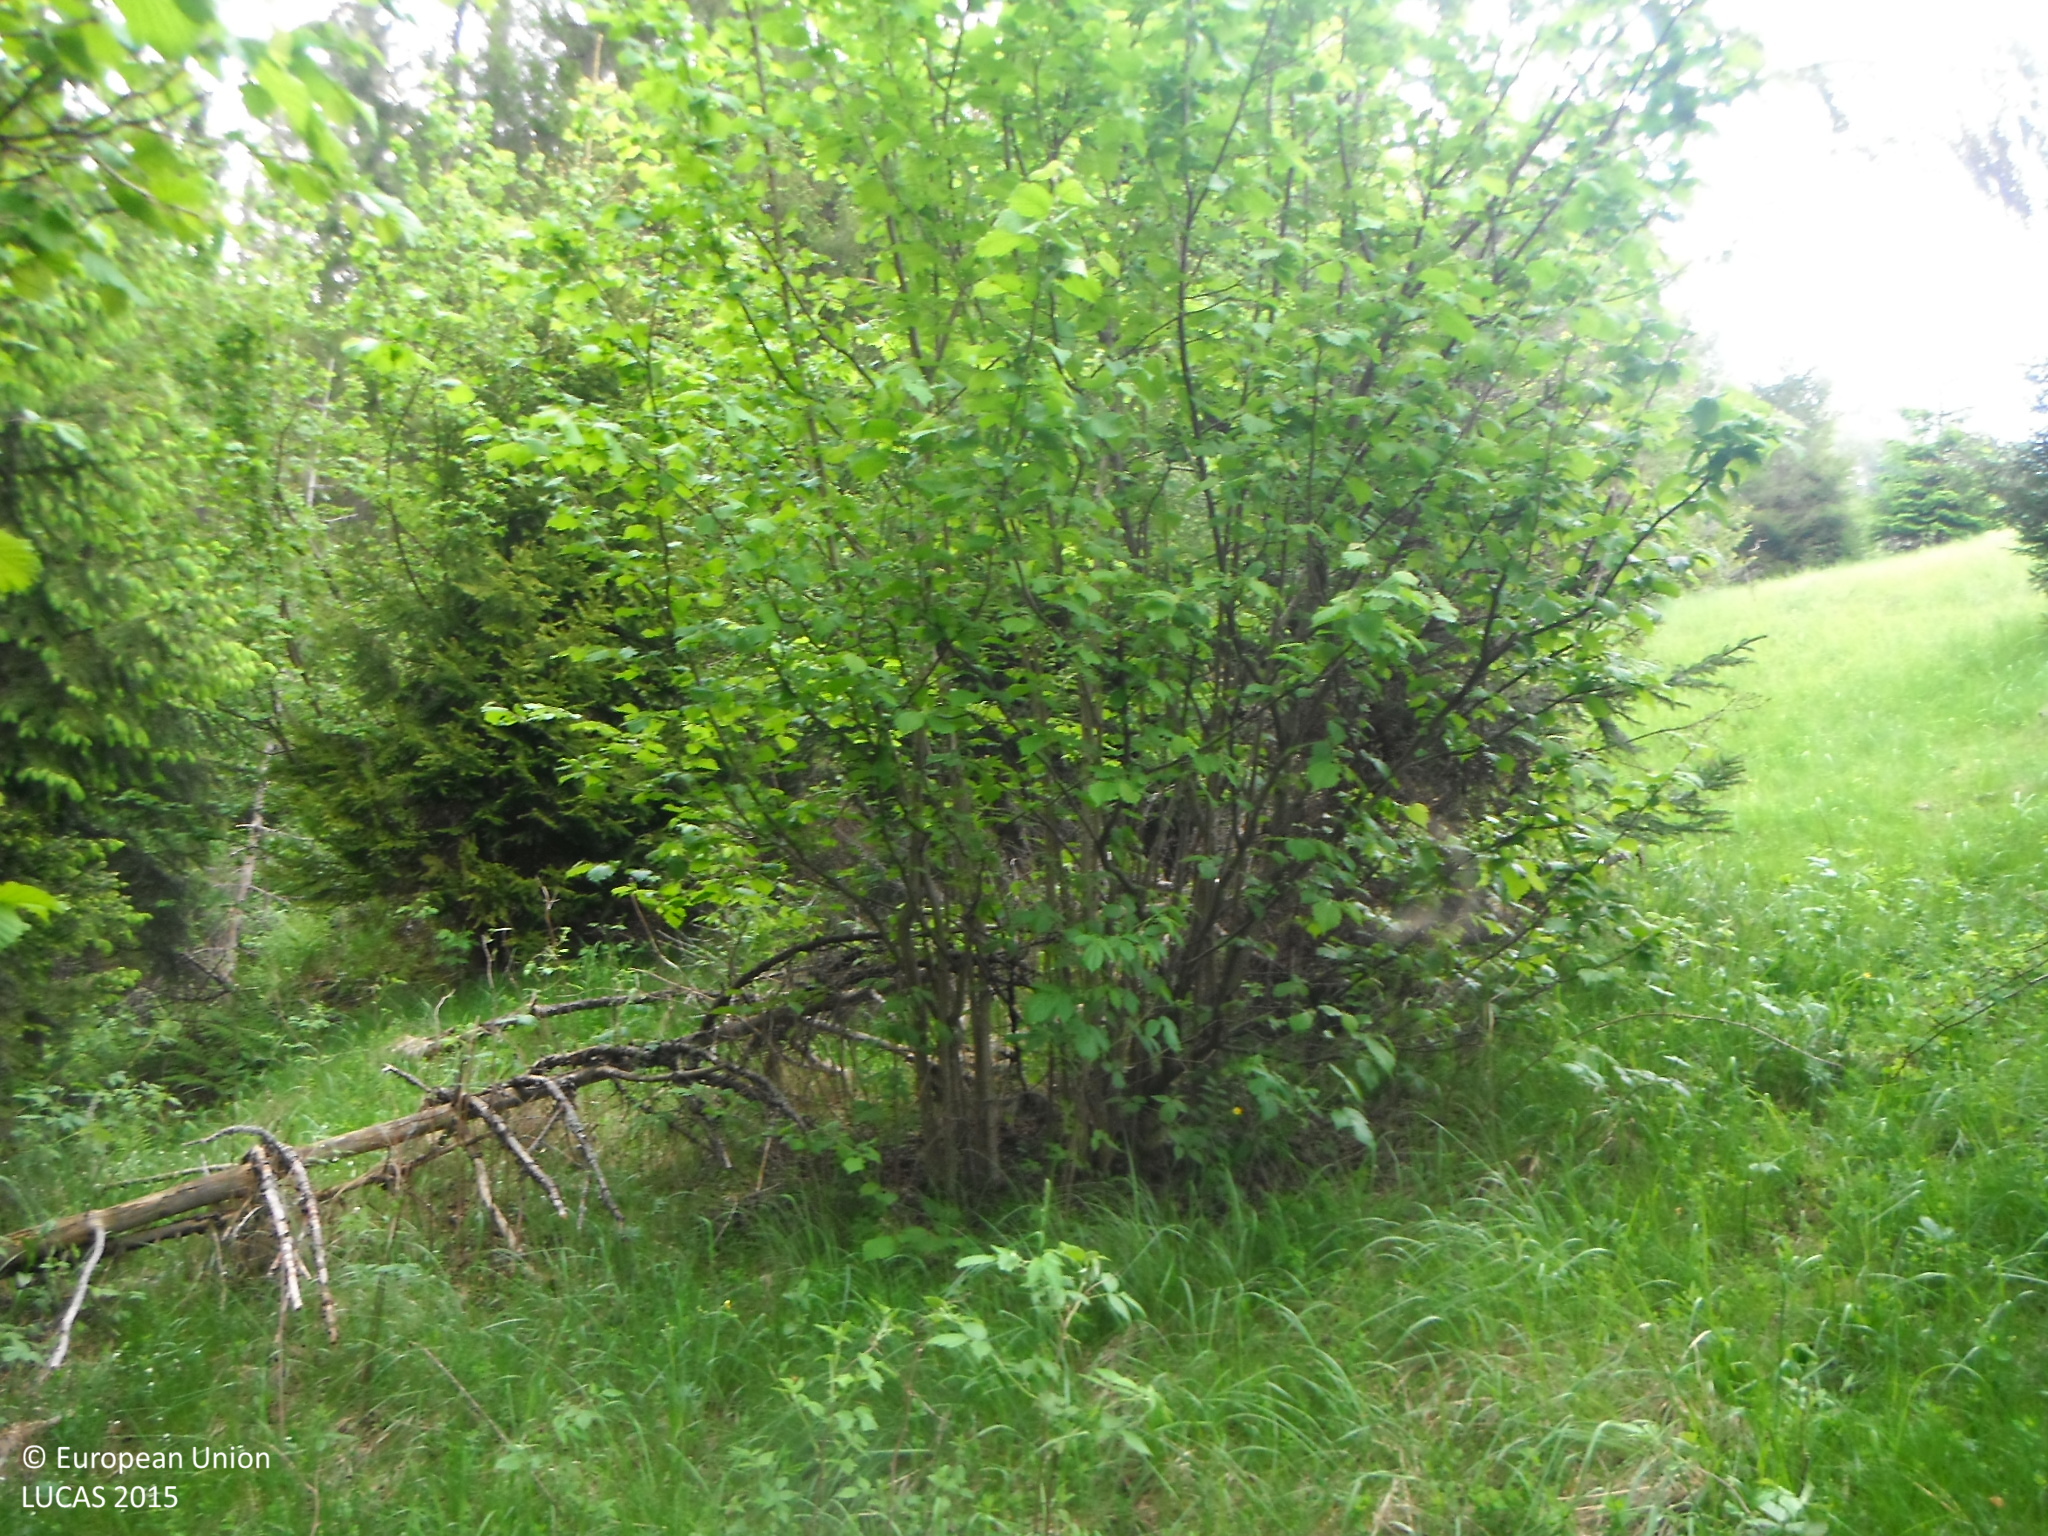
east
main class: Woodland
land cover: Other mixed woodland
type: hemiboreal forest and nemoral coniferous forest and mixed broadleaved-coniferous forest
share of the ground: > 75 %
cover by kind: broadleaved forest trees 60 %, coniferous forest trees 40 %
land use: Forestry
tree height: > 5 m
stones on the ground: 10 - 25 %
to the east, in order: Other mixed woodland; Ditches and canals; Other mixed woodland
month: June
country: SK
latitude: 49.0952
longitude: 20.7348
